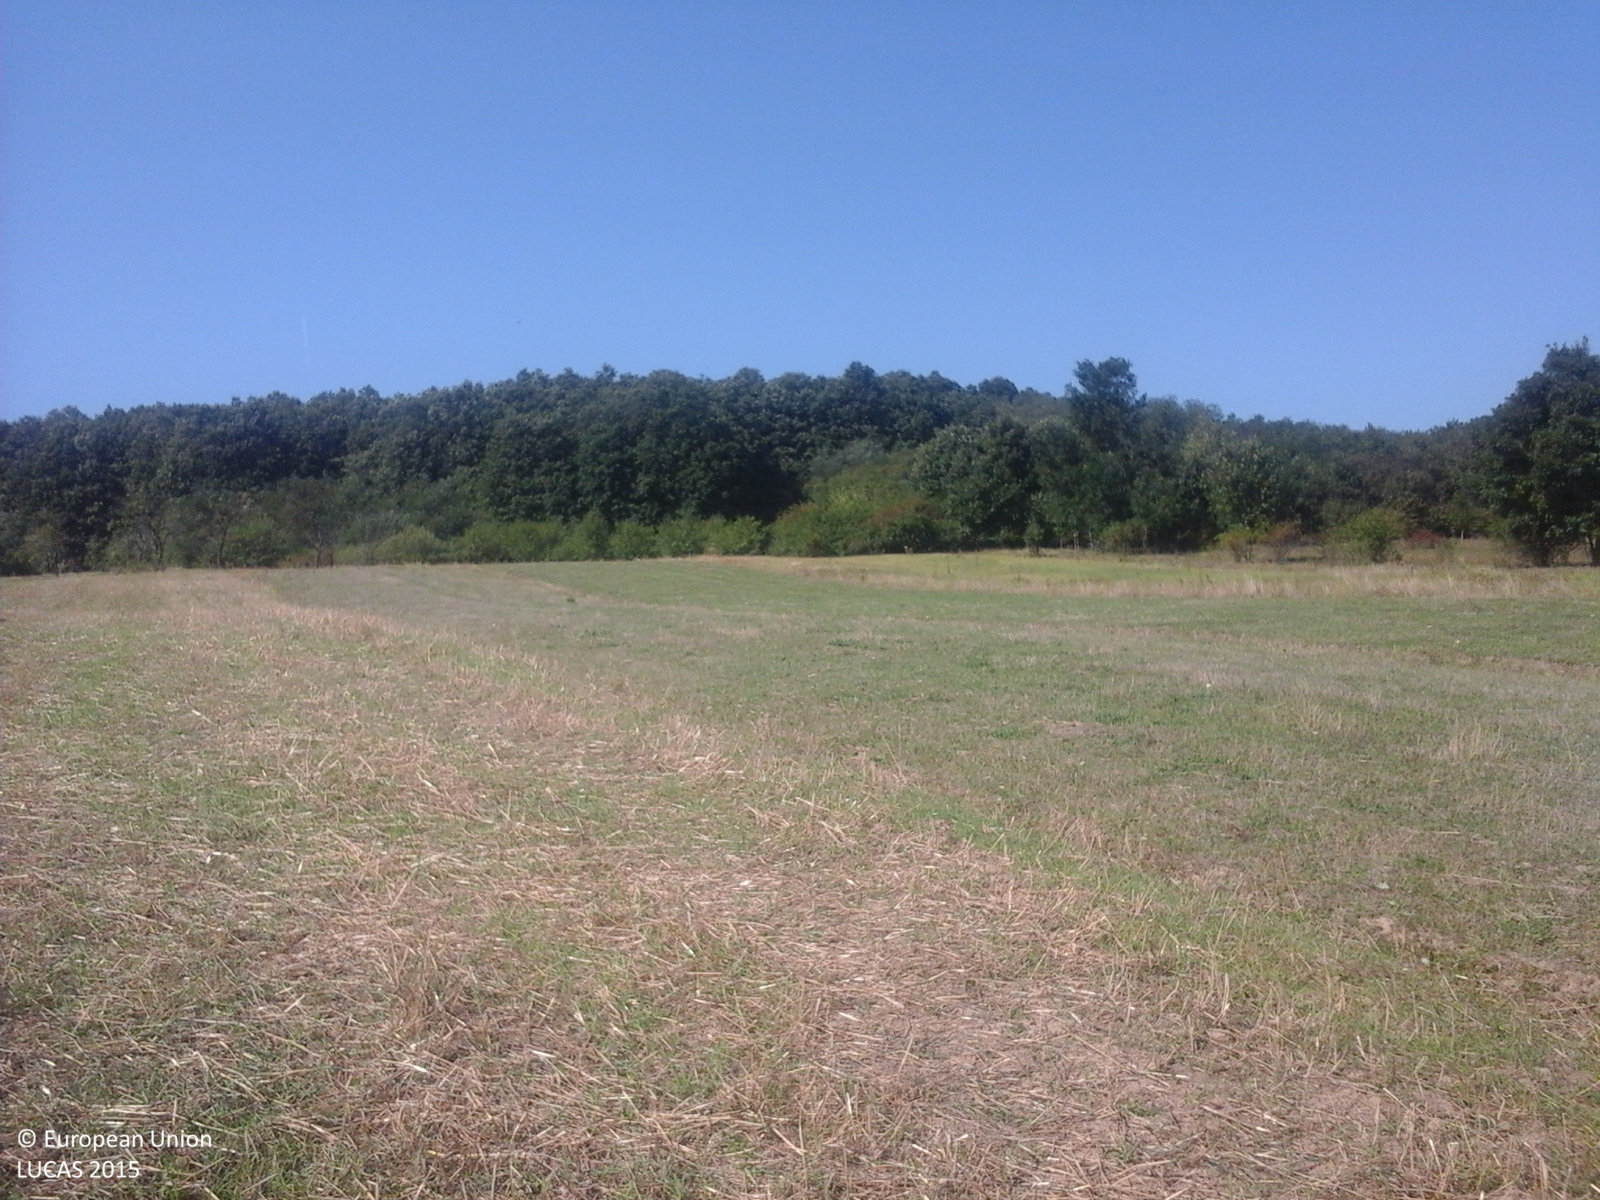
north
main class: Cropland
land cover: Common wheat
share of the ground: < 10 %
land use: Agriculture (excluding fallow land and kitchen gardens)
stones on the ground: < 10 %
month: September
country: RO
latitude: 47.1621
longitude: 22.8158
